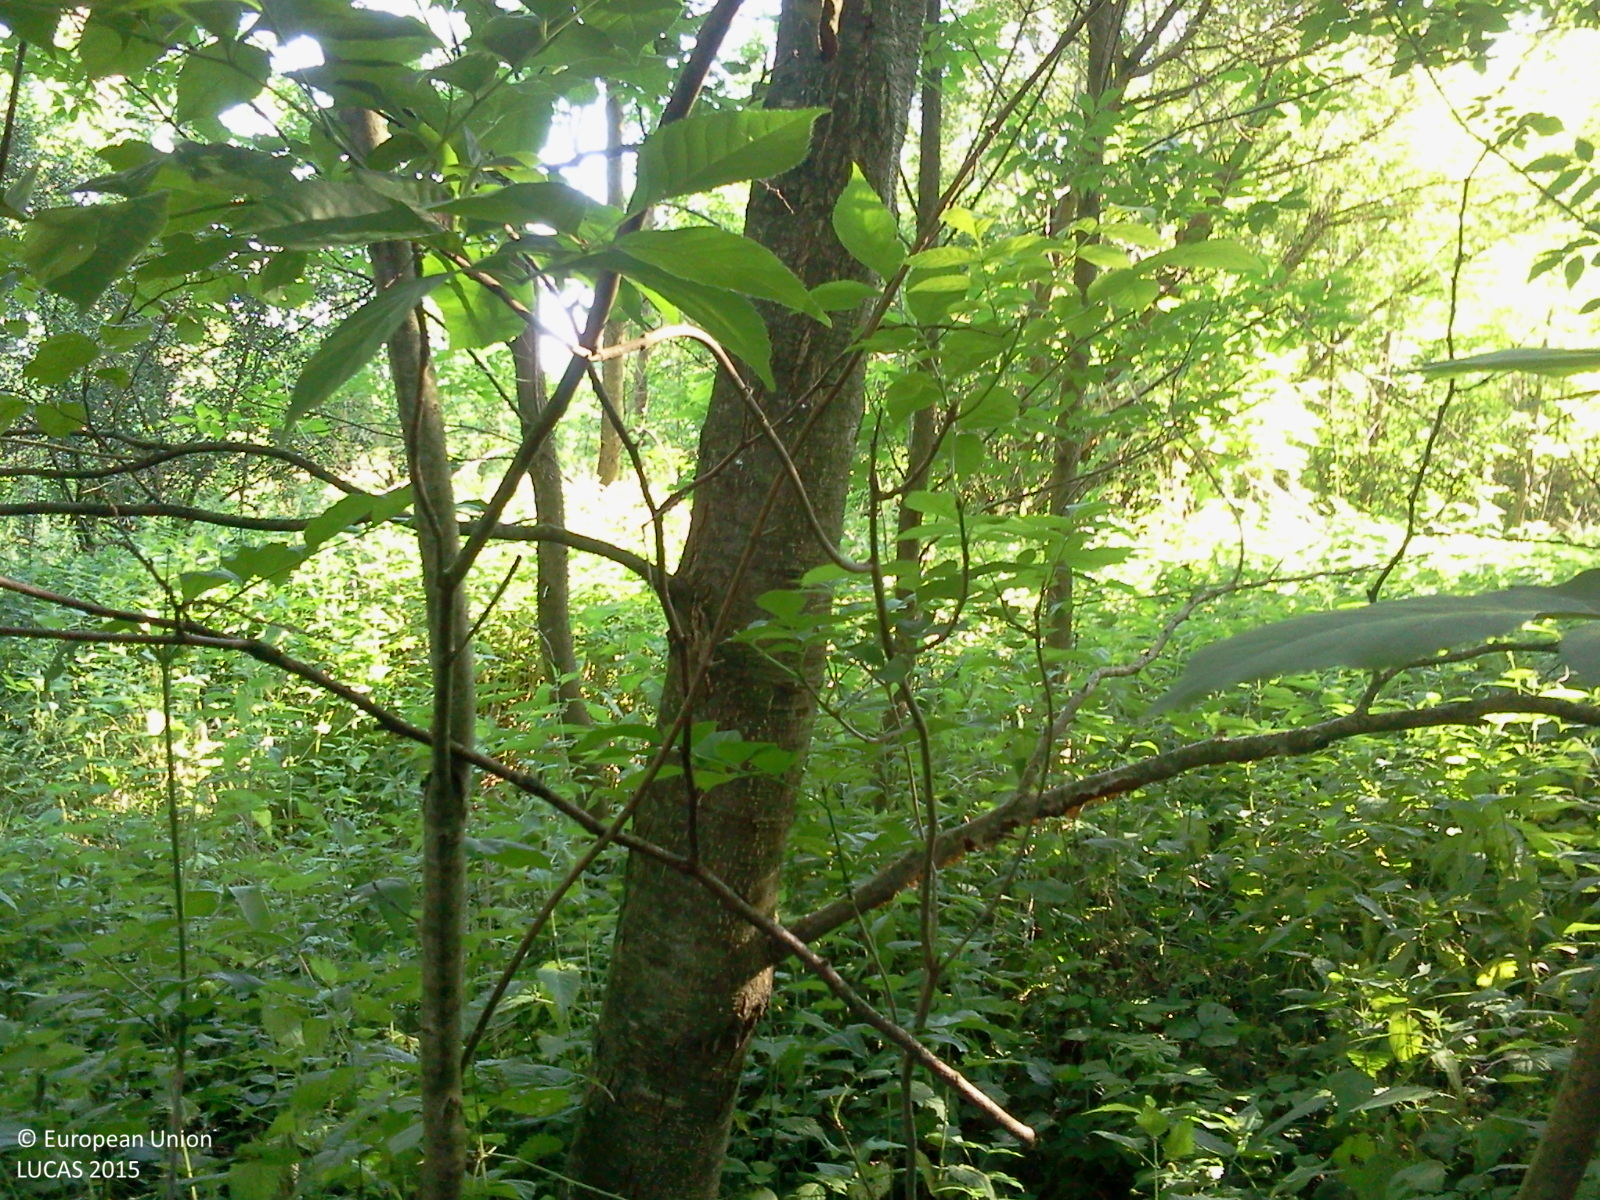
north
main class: Woodland
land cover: Broadleaved woodland
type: thermophilous deciduous forest
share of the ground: > 75 %
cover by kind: broadleaved forest trees 65 %, shrubs 20 %, herbaceous plants 15 %
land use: Forestry
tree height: > 5 m
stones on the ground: < 10 %
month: June
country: HU
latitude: 46.6950
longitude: 17.0784
